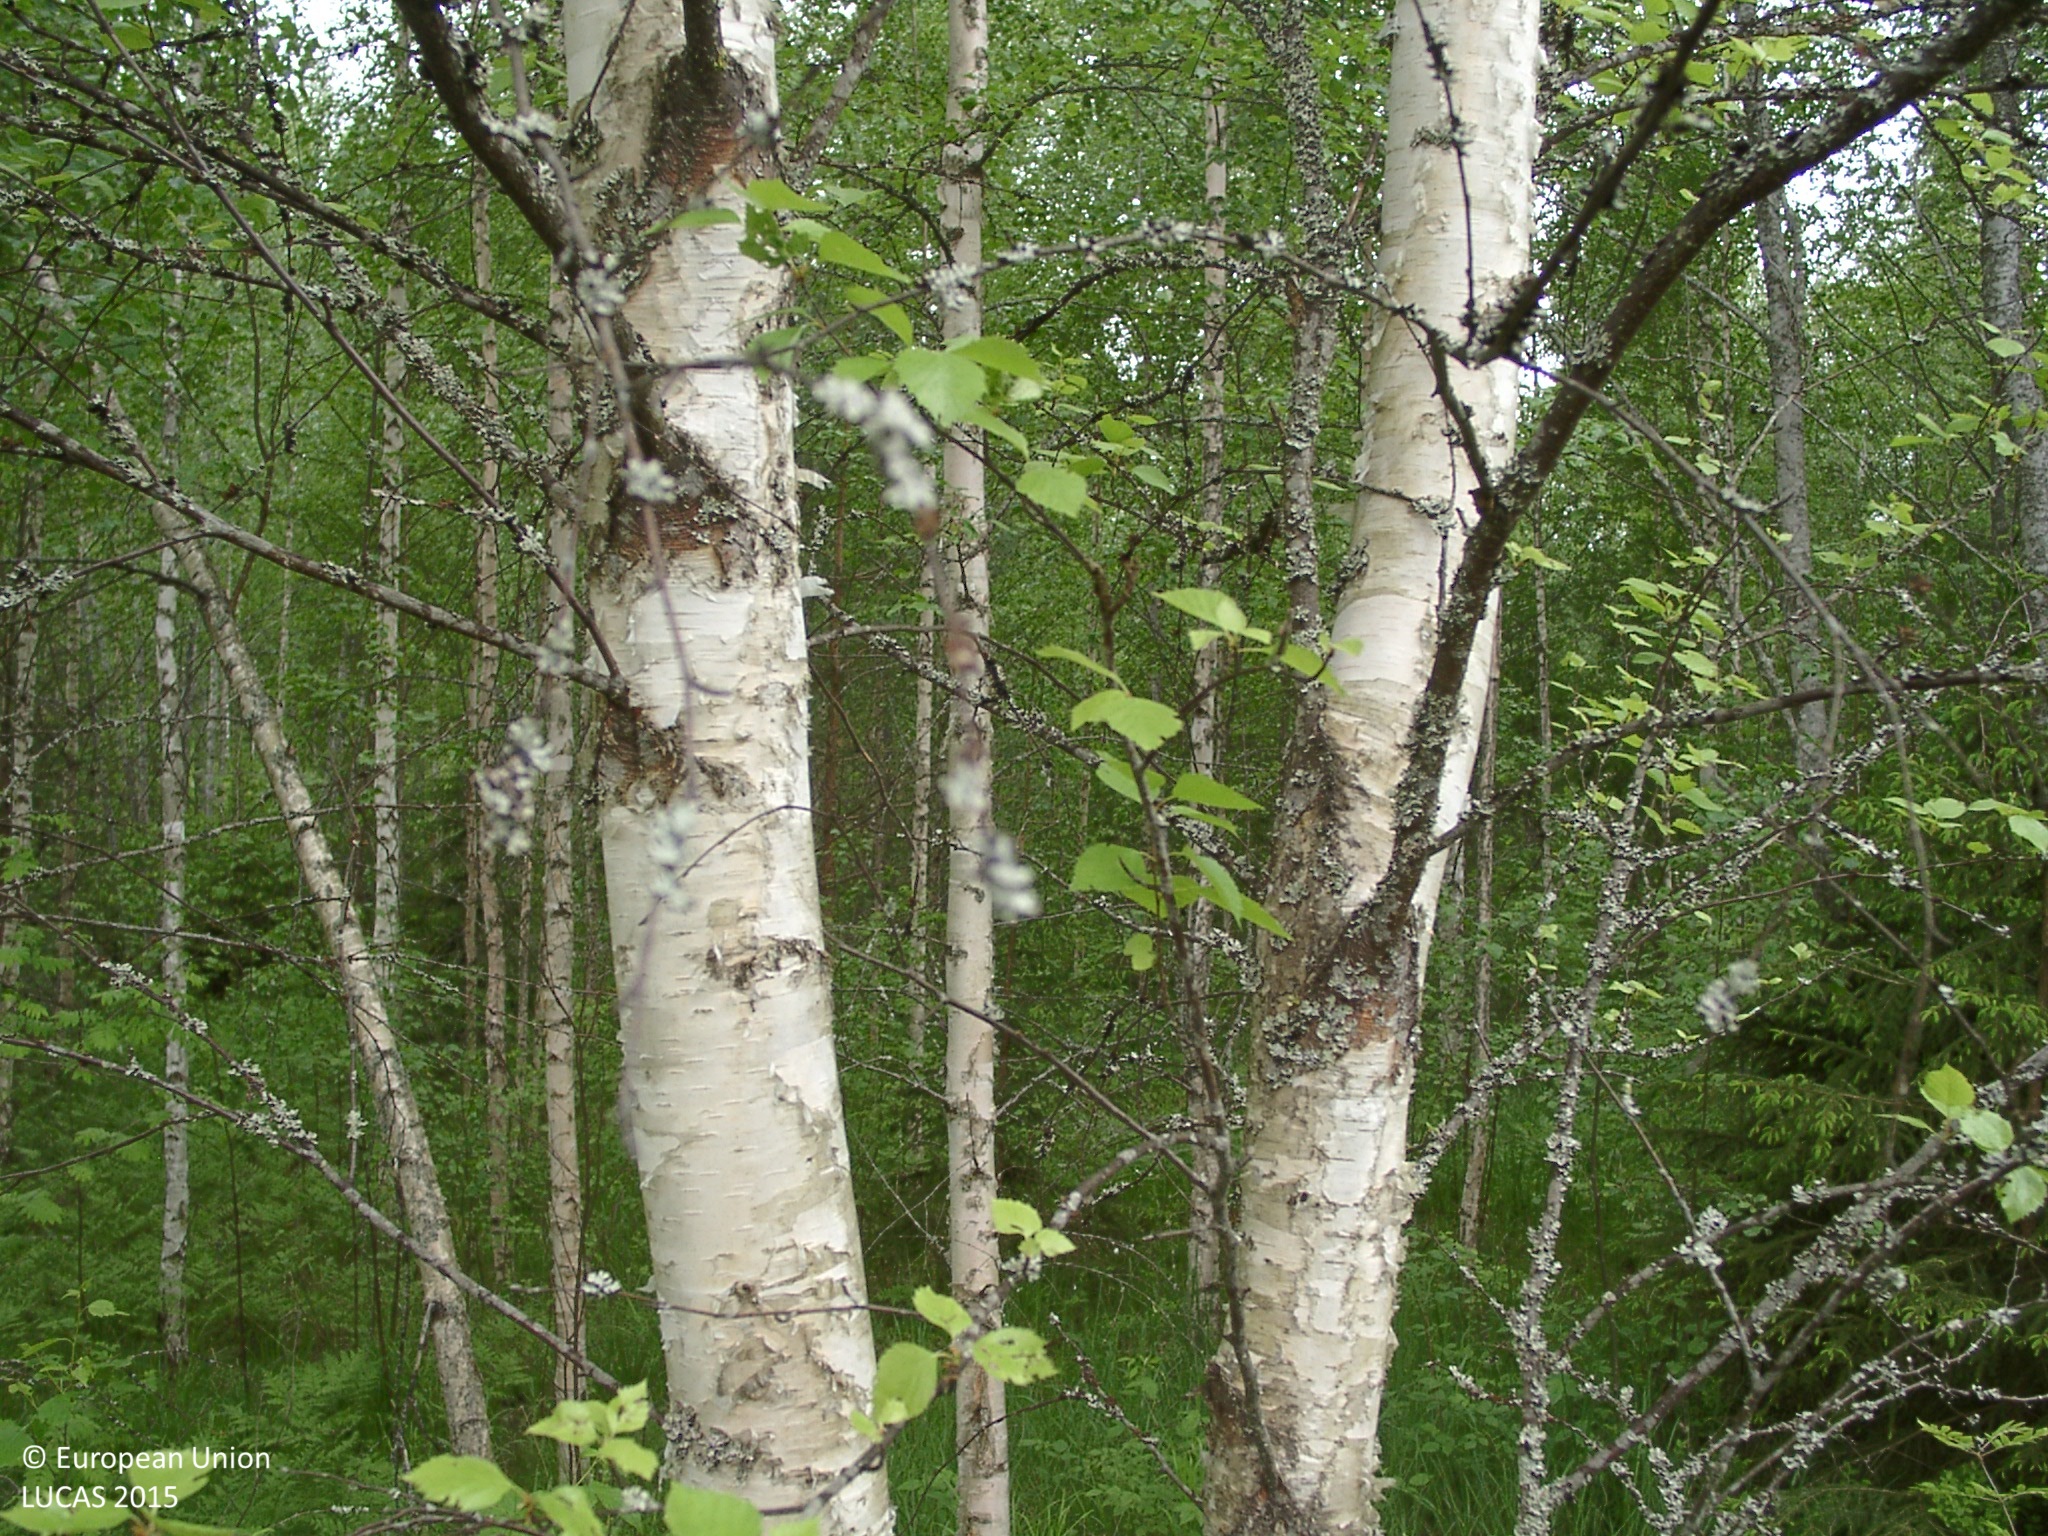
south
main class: Shrubland
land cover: Shrubland with sparse tree cover
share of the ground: 25 - 50 %
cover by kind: herbaceous plants 50 %, shrubs 40 %, broadleaved forest trees 5 %, consolidated bare surface 5 %
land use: Forestry
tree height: < 5 m
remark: Clear cut
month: June
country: FI
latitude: 61.6080
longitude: 24.7125
